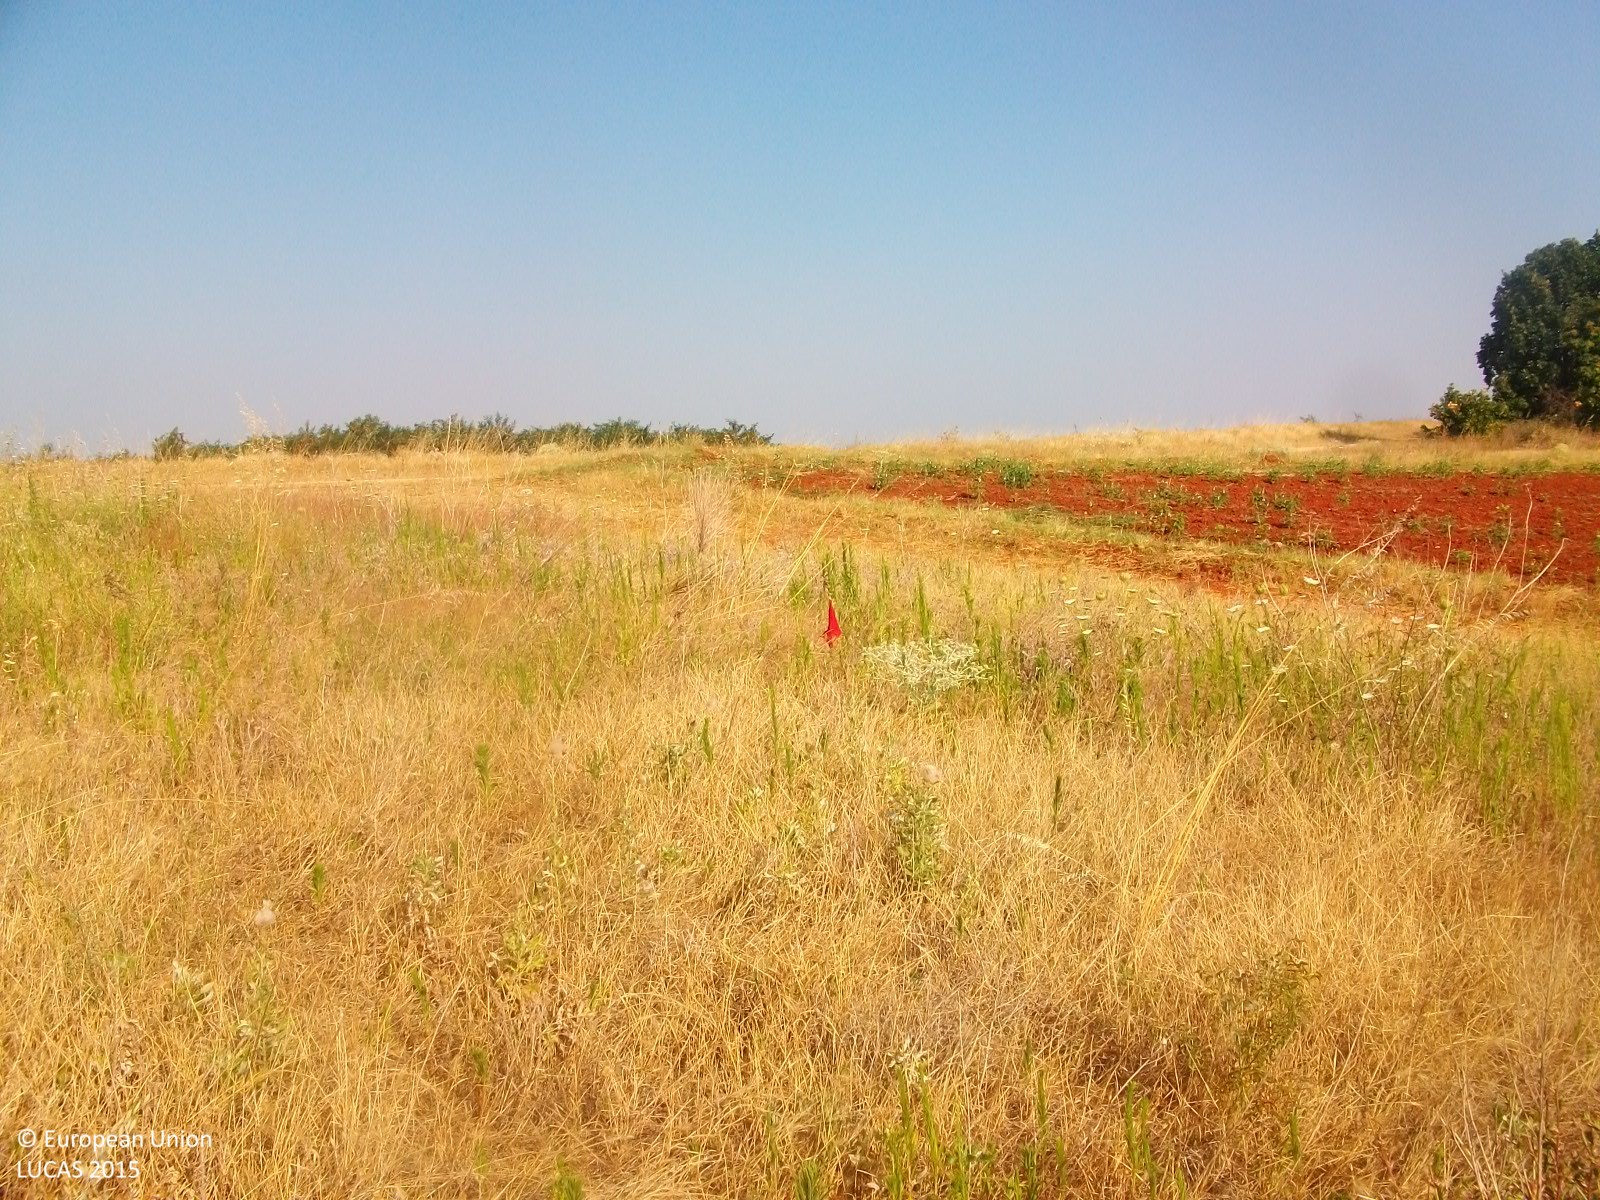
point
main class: Grassland
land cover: Spontaneously vegetated surfaces
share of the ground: > 75 %
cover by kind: herbaceous plants 100 %
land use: Fallow land
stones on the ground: 25 - 50 %
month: July
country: GR
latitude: 41.3297
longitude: 26.2608
